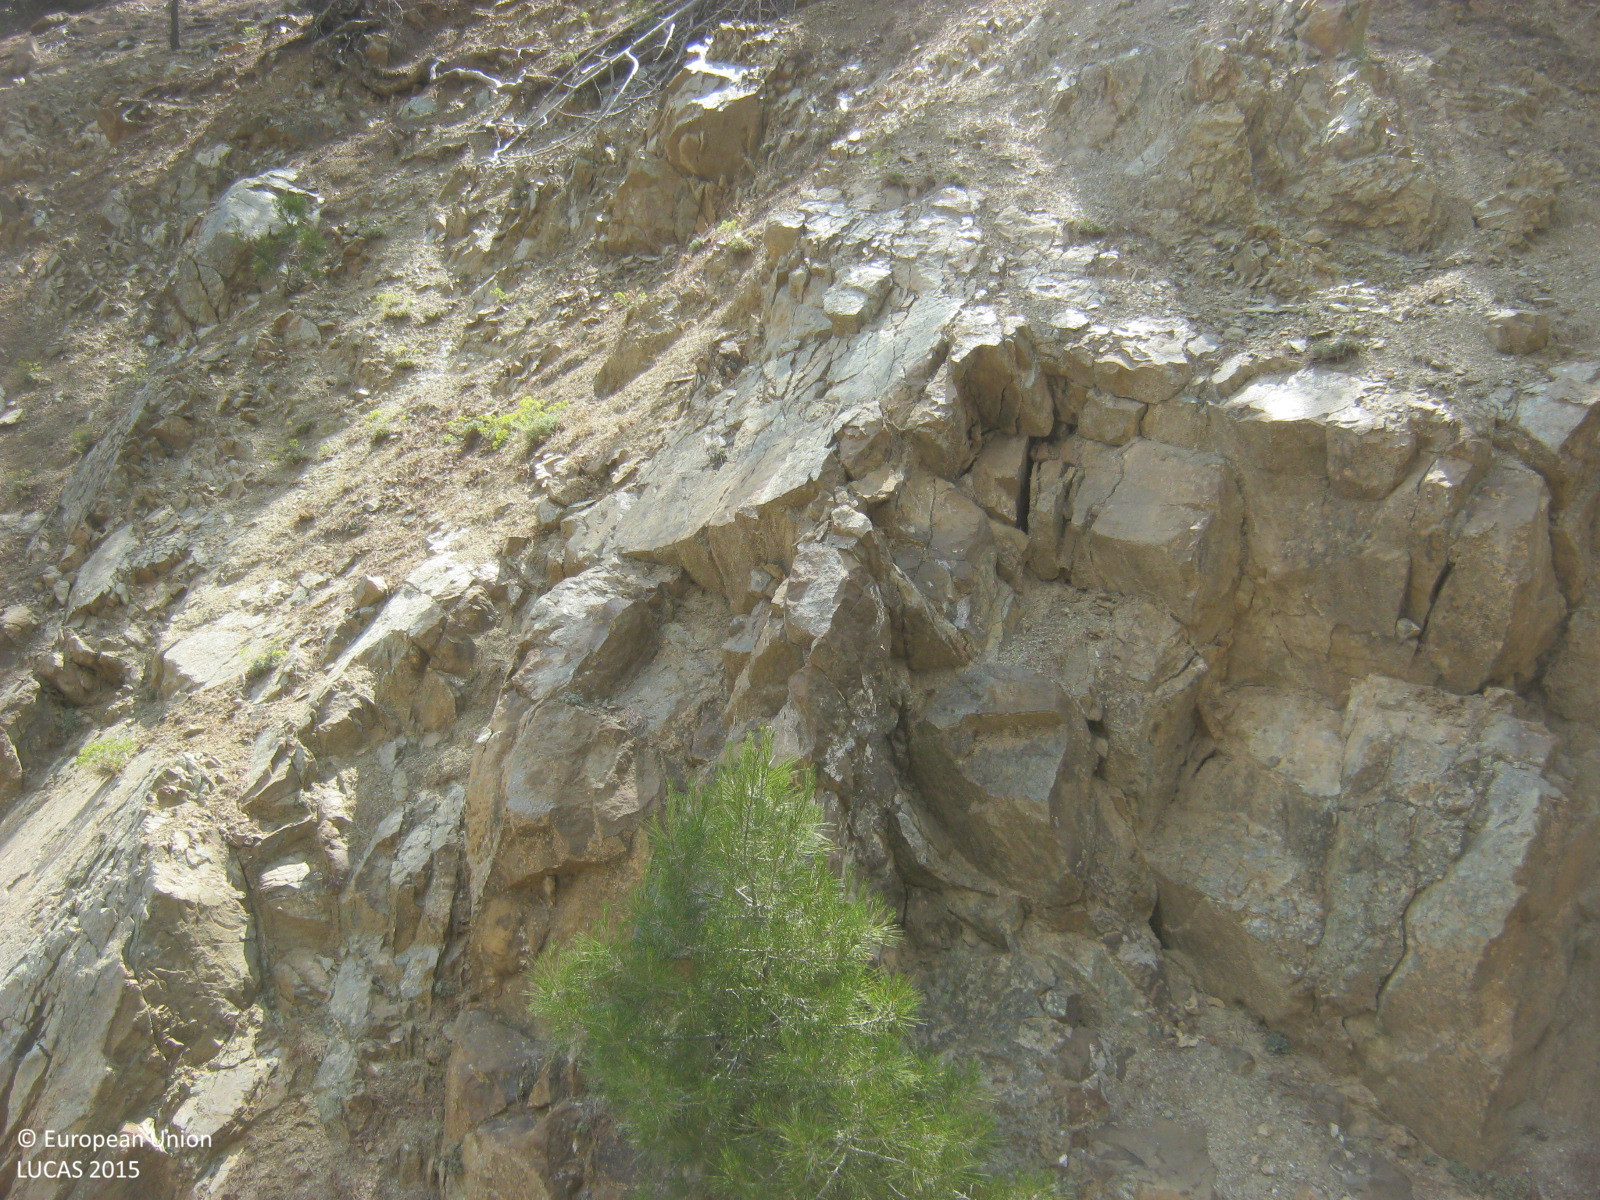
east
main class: Woodland
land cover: Pine dominated coniferous woodland
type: coniferous forest of the mediterranean region
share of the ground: 10 - 25 %
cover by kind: unconsolidated bare surface 65 %, coniferous forest trees 15 %, shrubs 10 %, consolidated bare surface 10 %
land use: Forestry
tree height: > 5 m
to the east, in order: Pine dominated coniferous woodland; Tracks; Pine dominated coniferous woodland
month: June
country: CY
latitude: 34.9585
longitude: 32.8693
